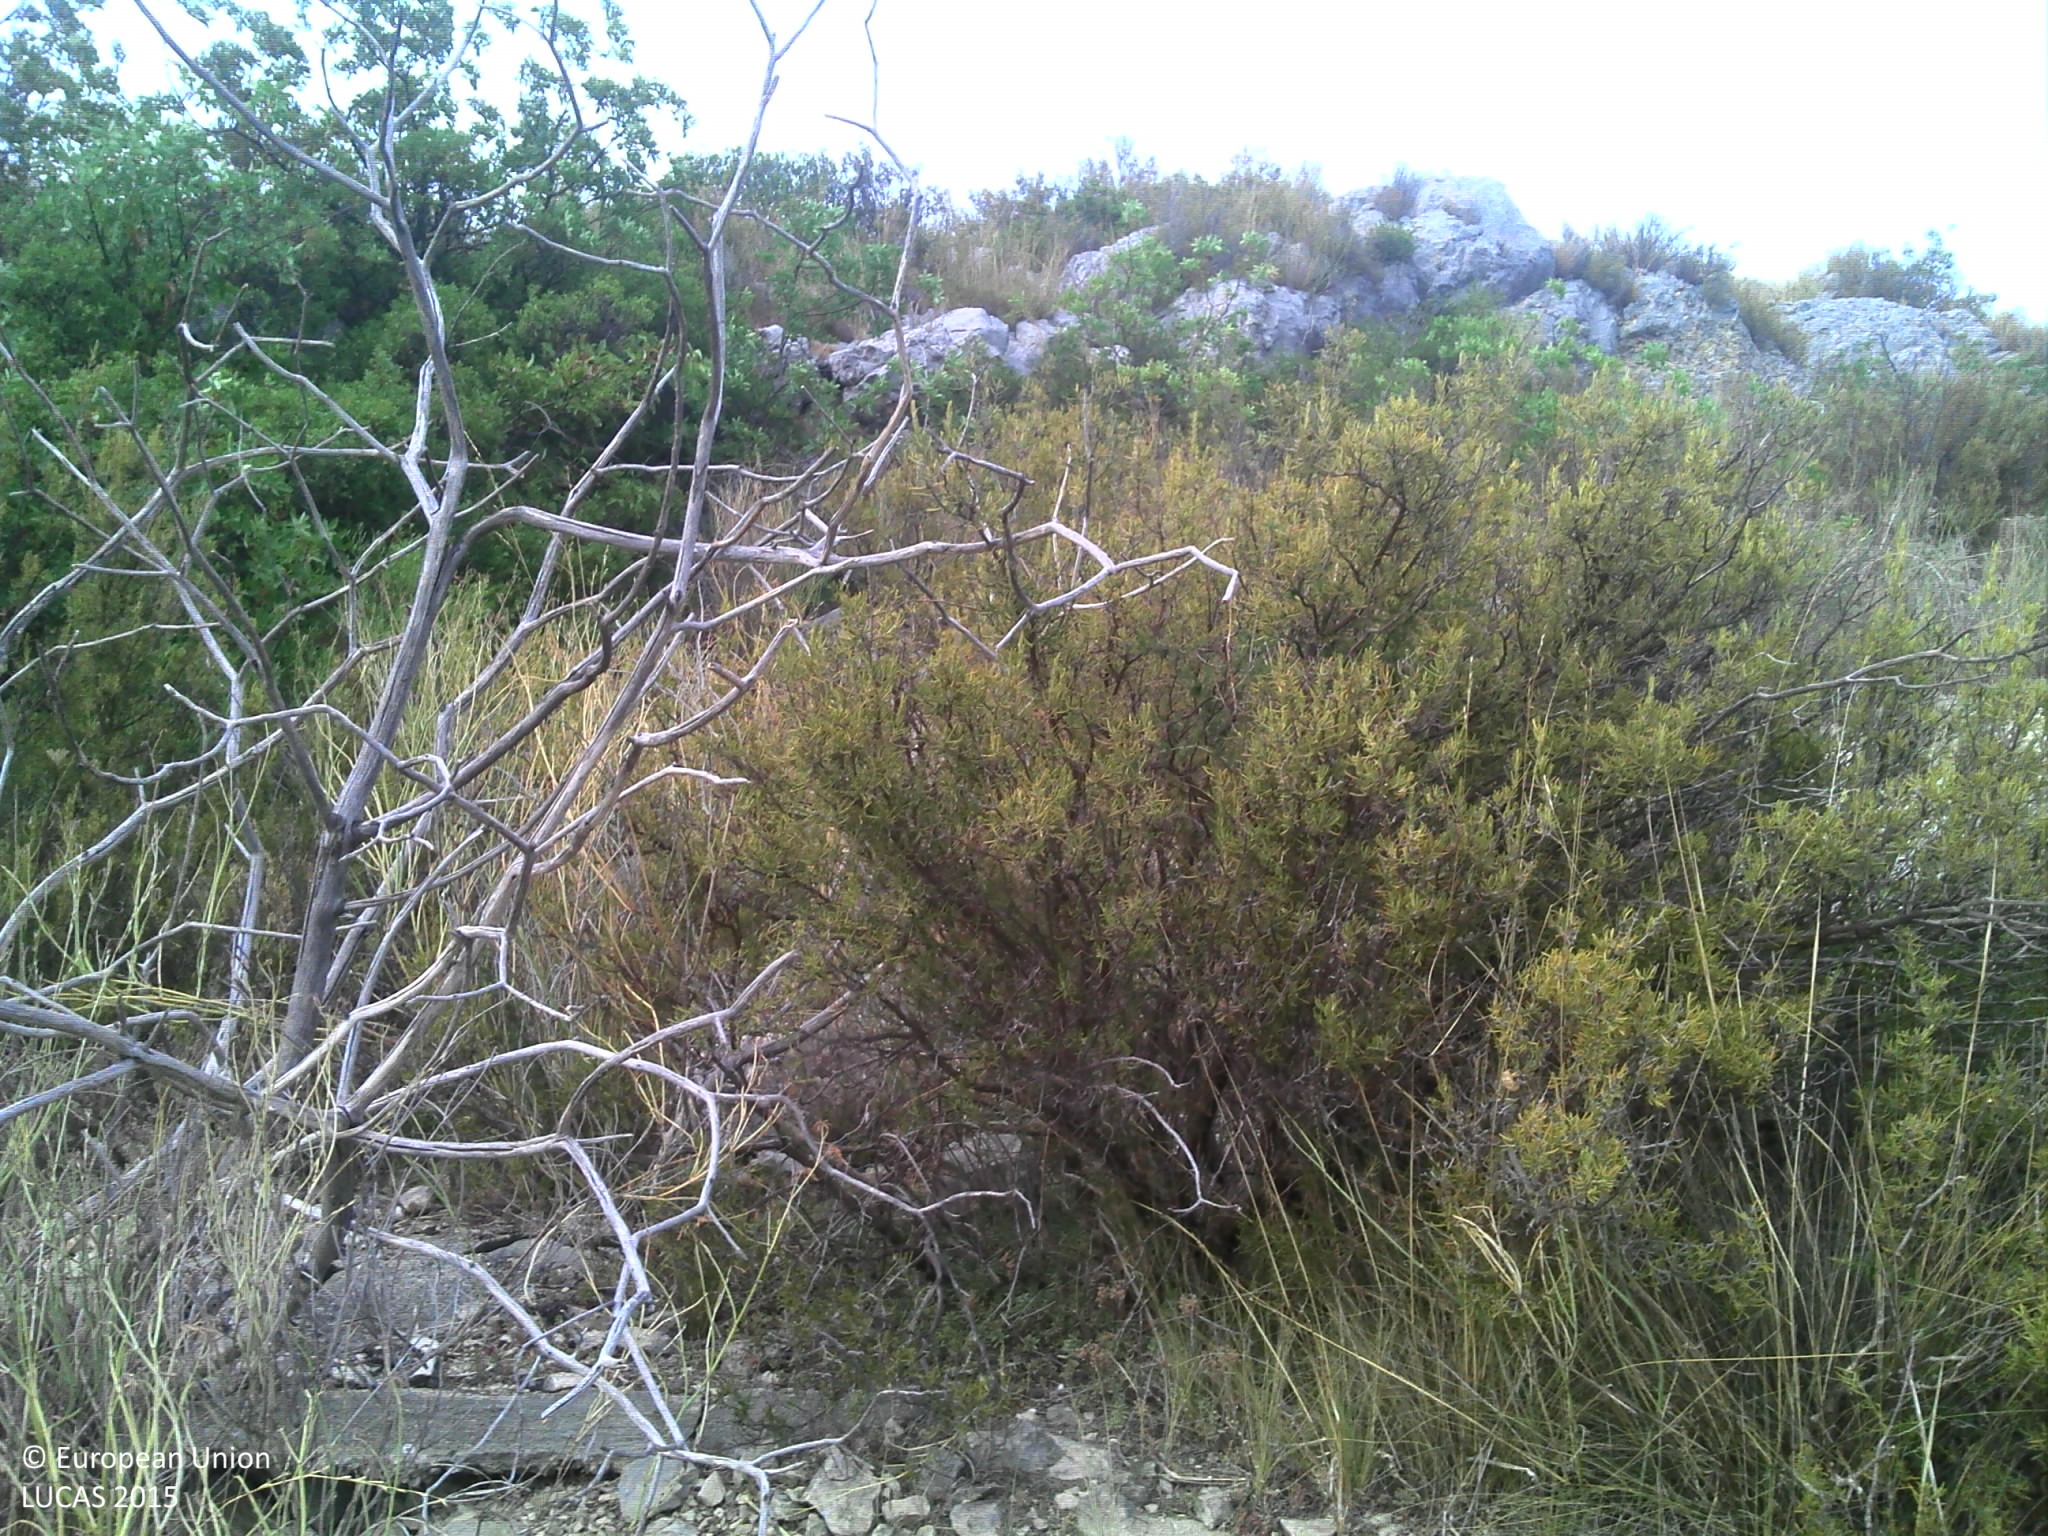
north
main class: Shrubland
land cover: Shrubland without tree cover
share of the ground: 50 - 75 %
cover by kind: shrubs 60 %, unconsolidated bare surface 35 %
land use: Semi-natural and natural areas not in use
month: August
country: FR
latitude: 43.3541
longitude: 5.6054
